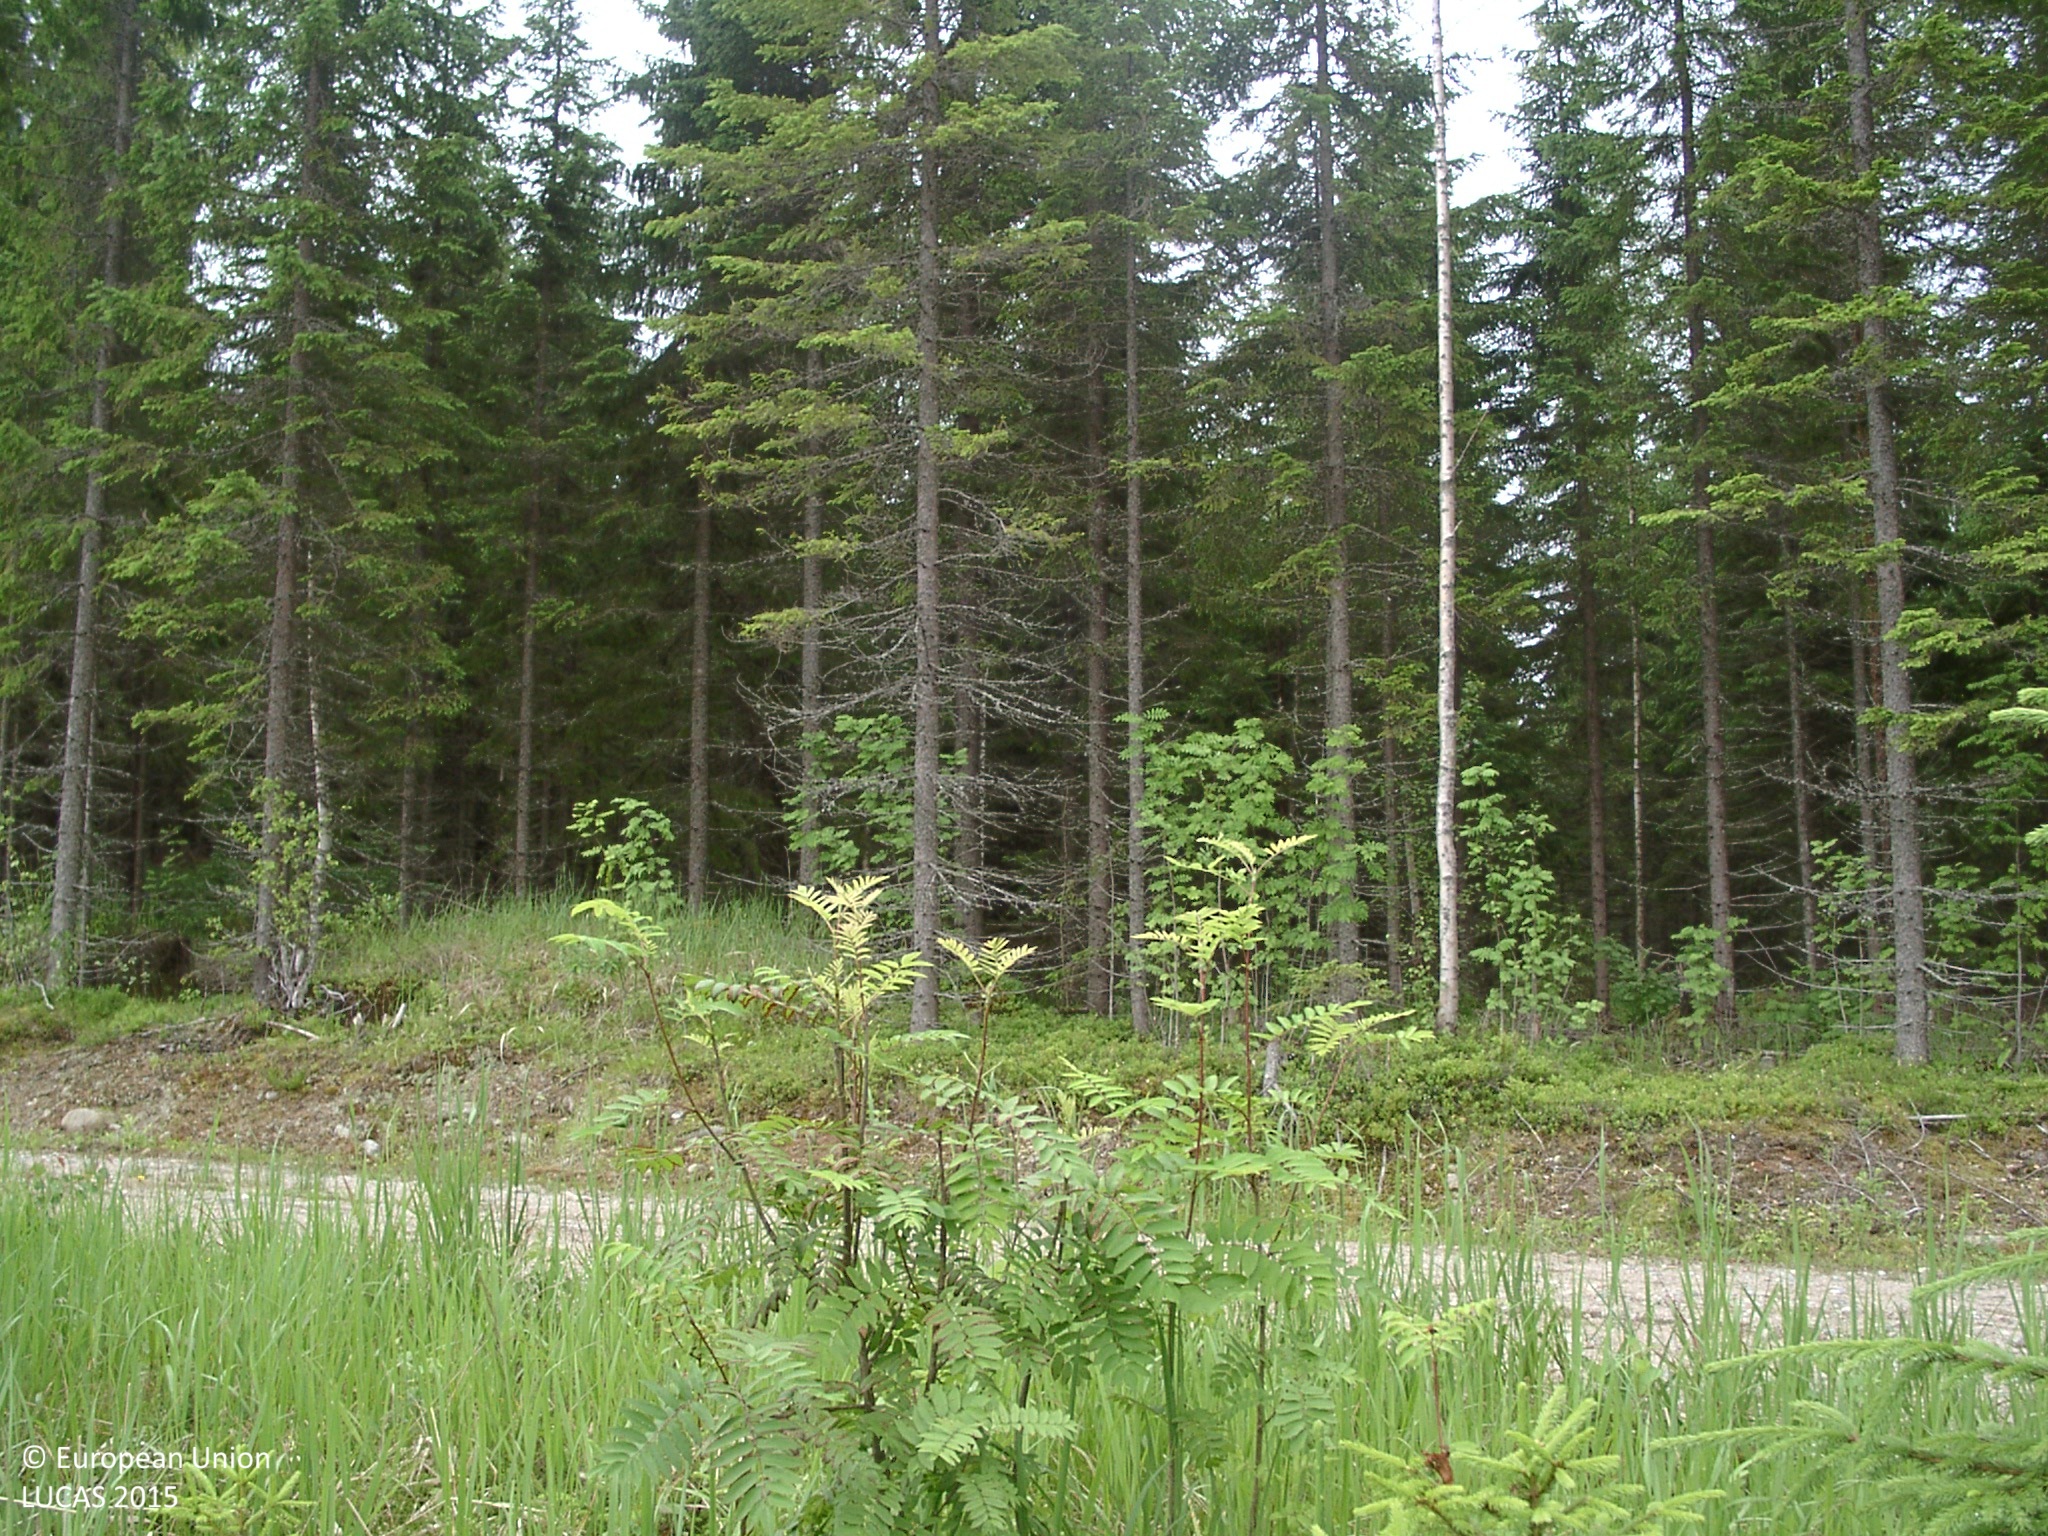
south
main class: Shrubland
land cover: Shrubland with sparse tree cover
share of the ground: 25 - 50 %
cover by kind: herbaceous plants 60 %, shrubs 30 %, broadleaved forest trees 5 %
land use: Forestry
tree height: < 5 m
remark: Nursery
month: July
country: FI
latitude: 62.0841
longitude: 25.4510
